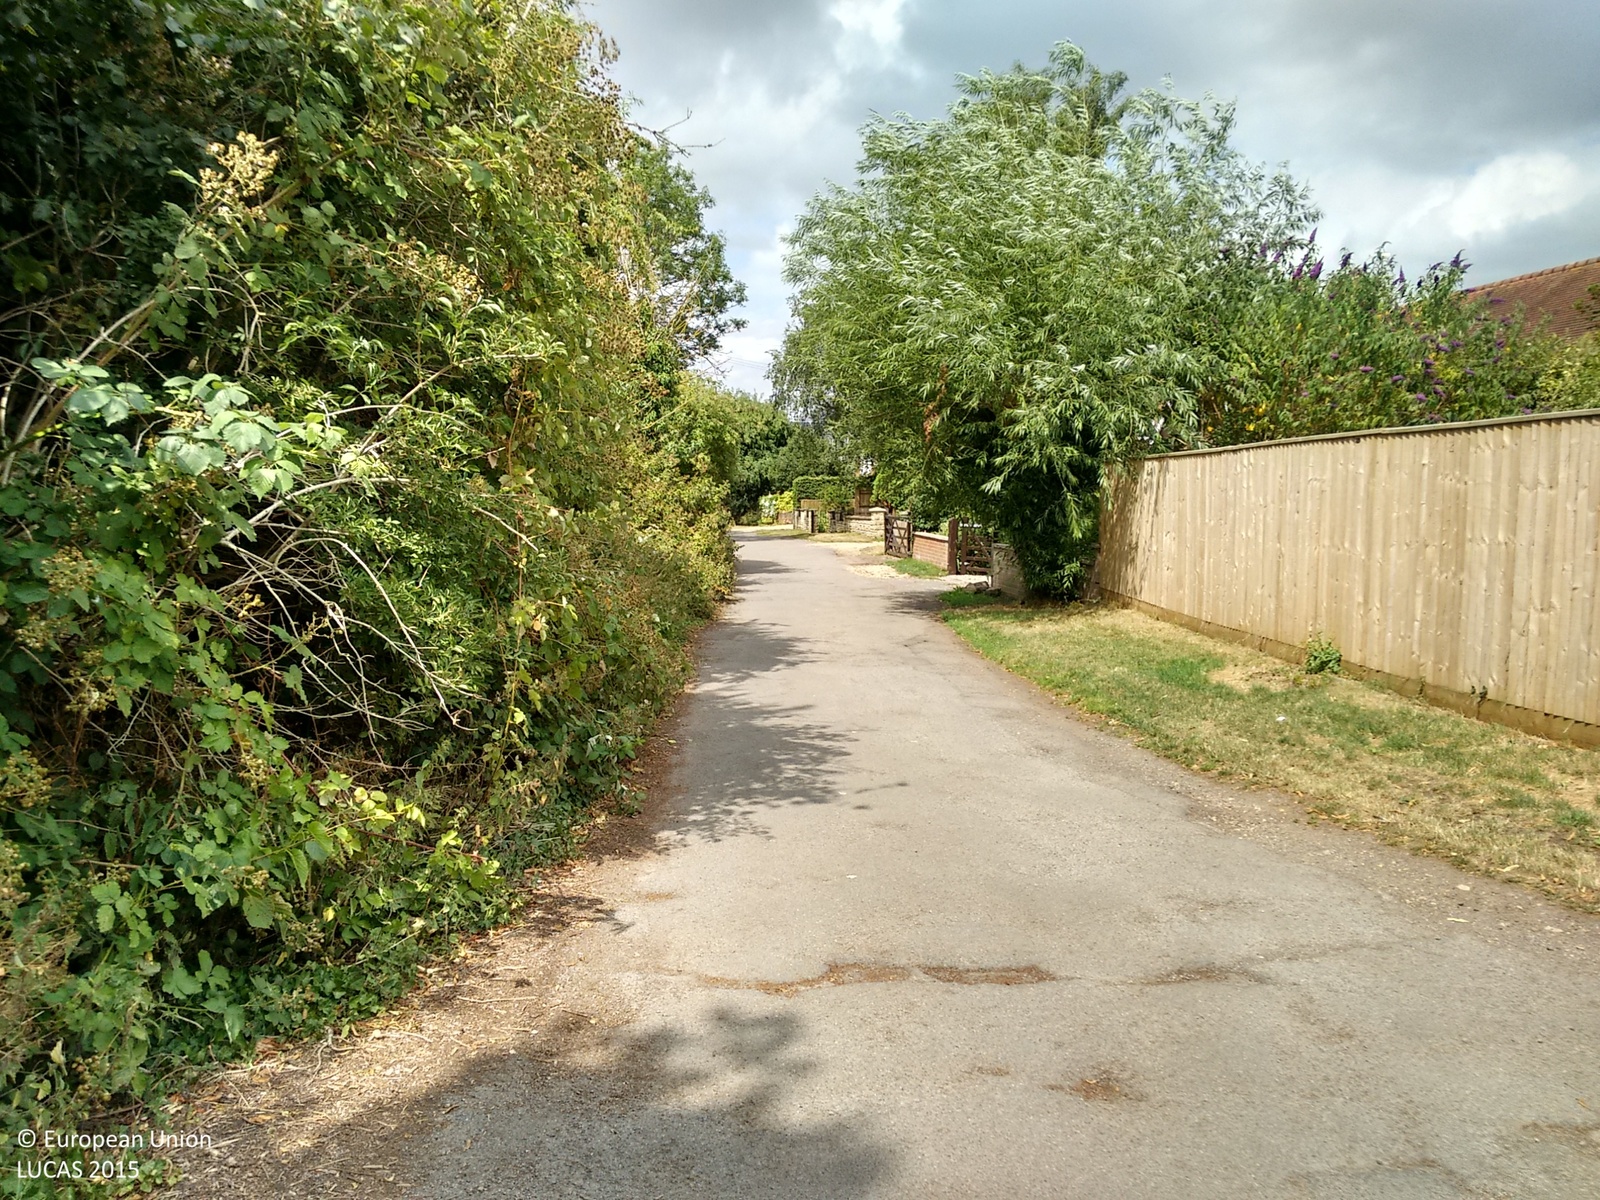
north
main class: Grassland
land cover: Grassland with sparse tree/shrub cover
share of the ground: > 75 %
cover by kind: herbaceous plants 95 %, broadleaved forest trees 5 %
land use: Agriculture (excluding fallow land and kitchen gardens)
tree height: > 5 m
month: July
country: GB
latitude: 51.7328
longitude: -1.2403
